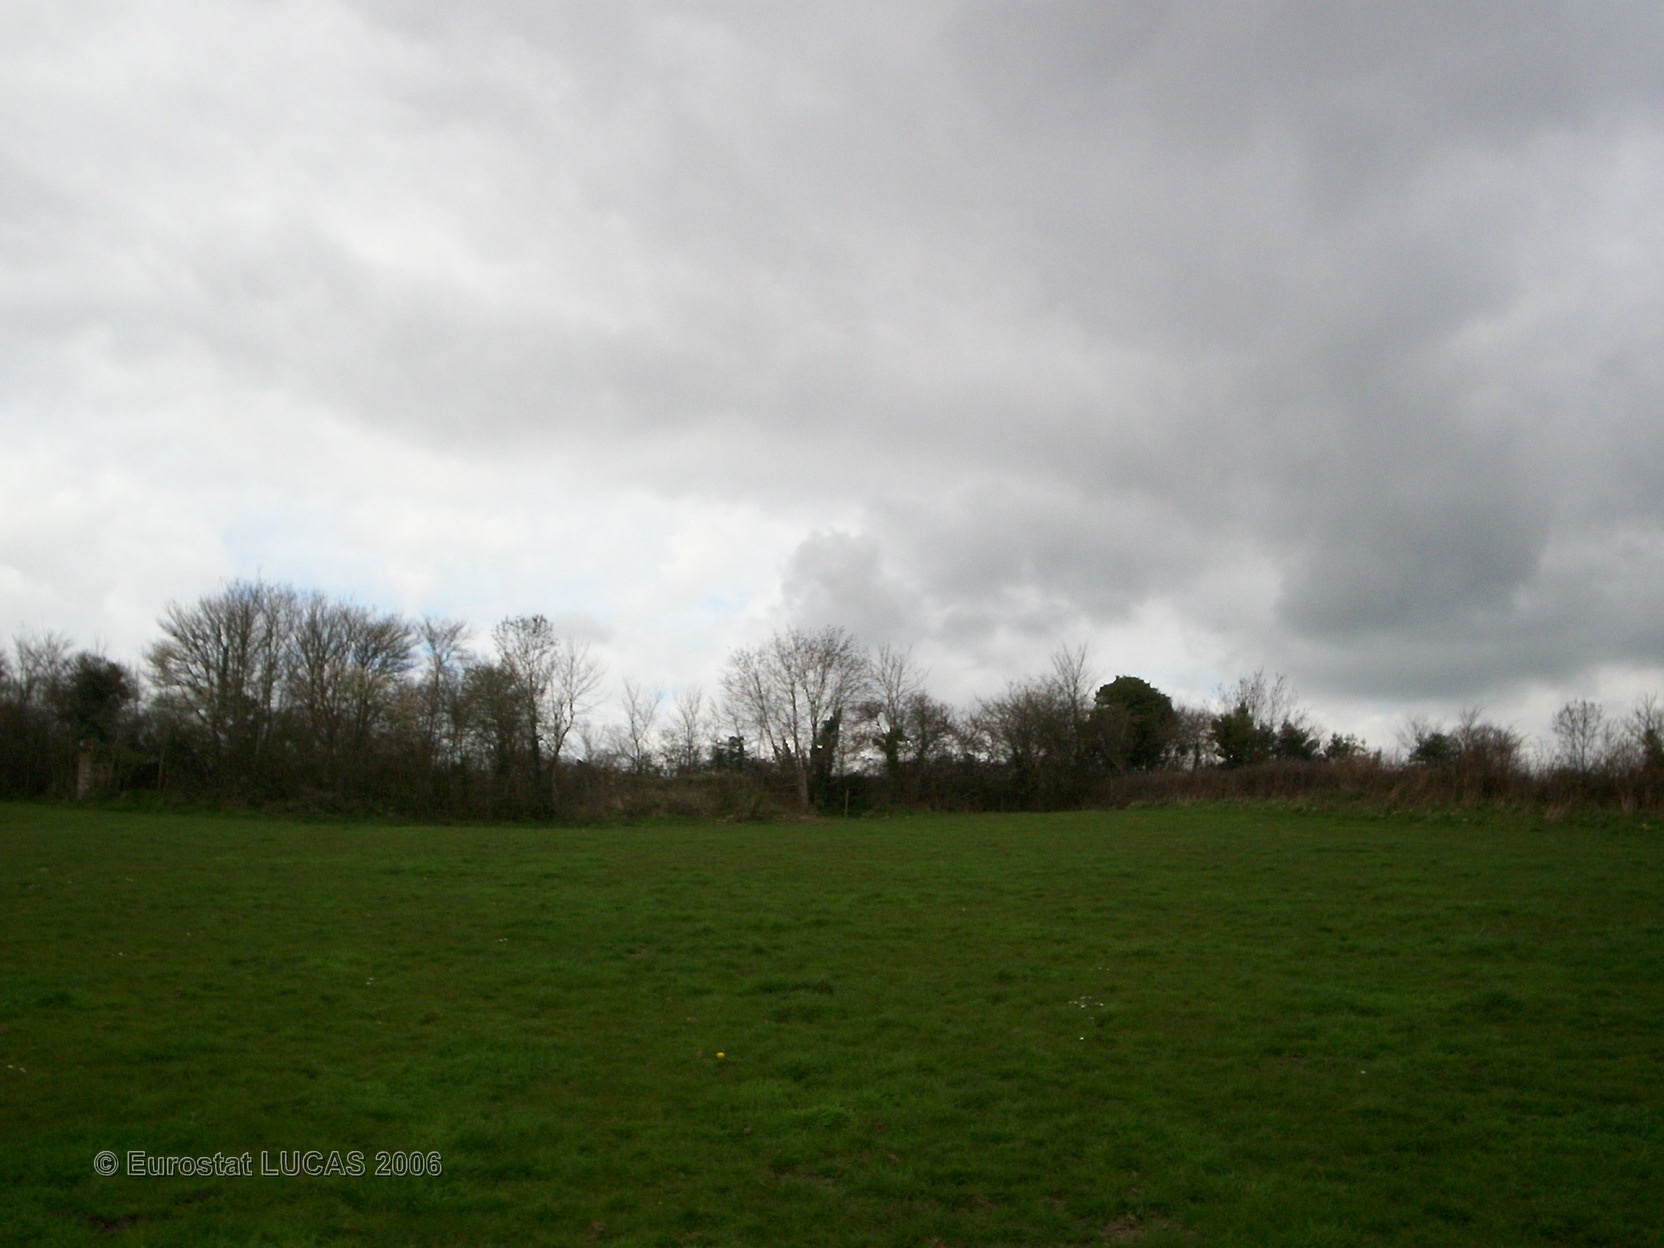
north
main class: Grassland
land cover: Grassland without tree/shrub cover
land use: Agriculture (excluding fallow land and kitchen gardens)
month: April
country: FR
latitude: 49.5356
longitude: -1.4207
